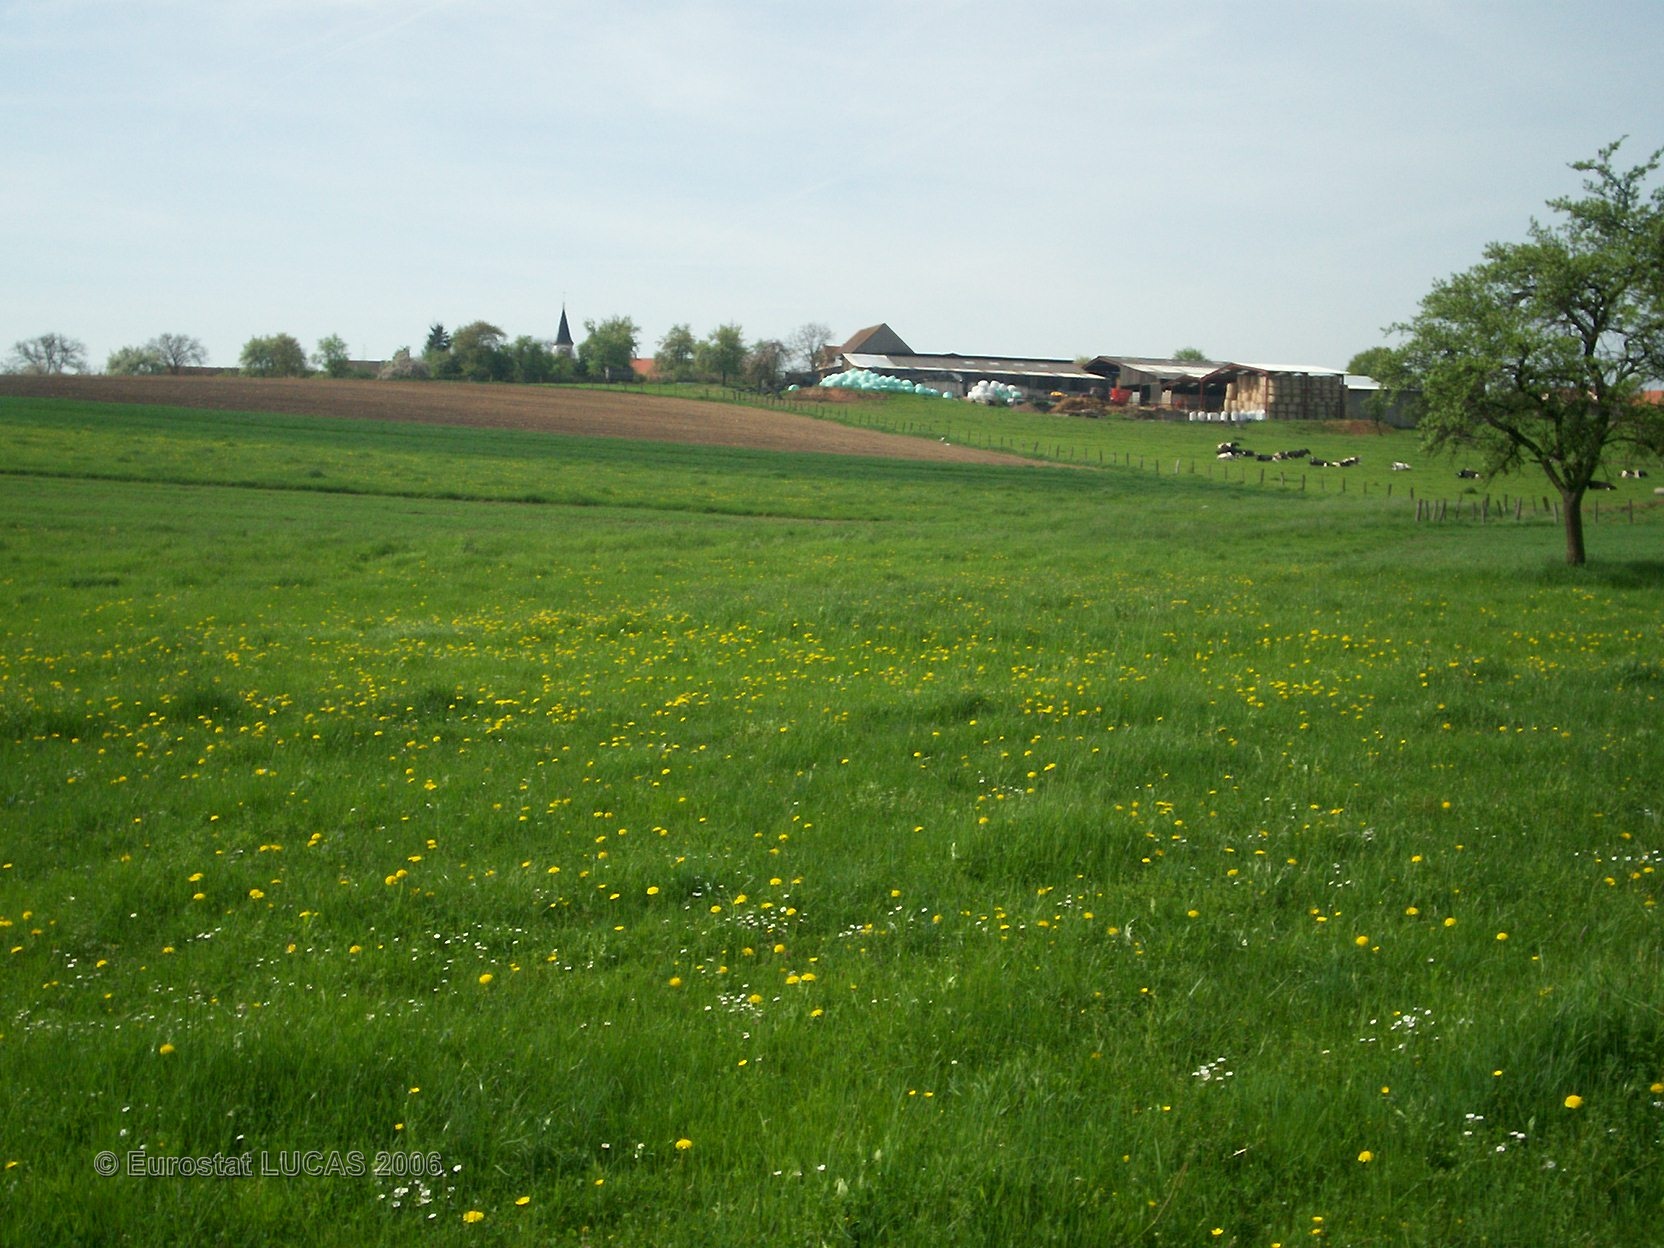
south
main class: Grassland
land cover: Grassland without tree/shrub cover
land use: Agriculture (excluding fallow land and kitchen gardens)
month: May
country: FR
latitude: 48.9565
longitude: 6.9823
